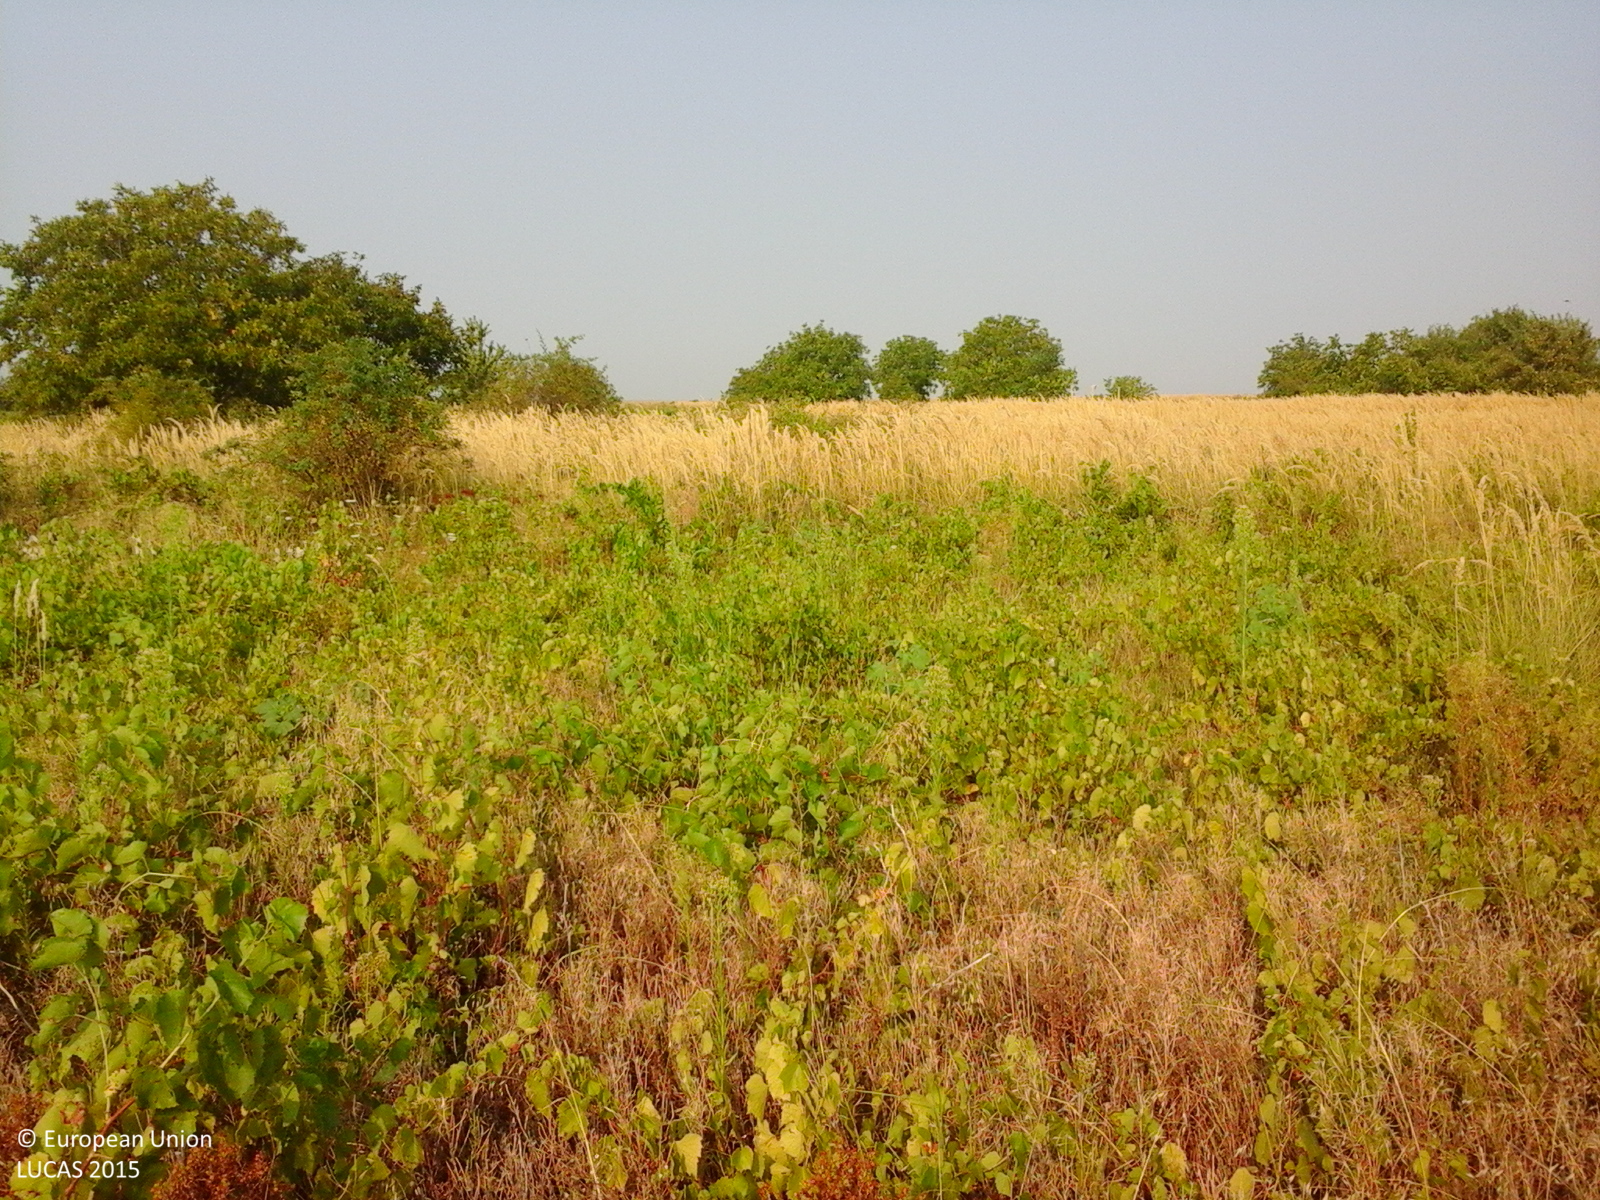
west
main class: Cropland
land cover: Vineyards
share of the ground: 25 - 50 %
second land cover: Spontaneously vegetated surfaces
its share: > 75 %
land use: Agriculture (excluding fallow land and kitchen gardens)
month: August
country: RO
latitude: 44.2603
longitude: 23.4150
